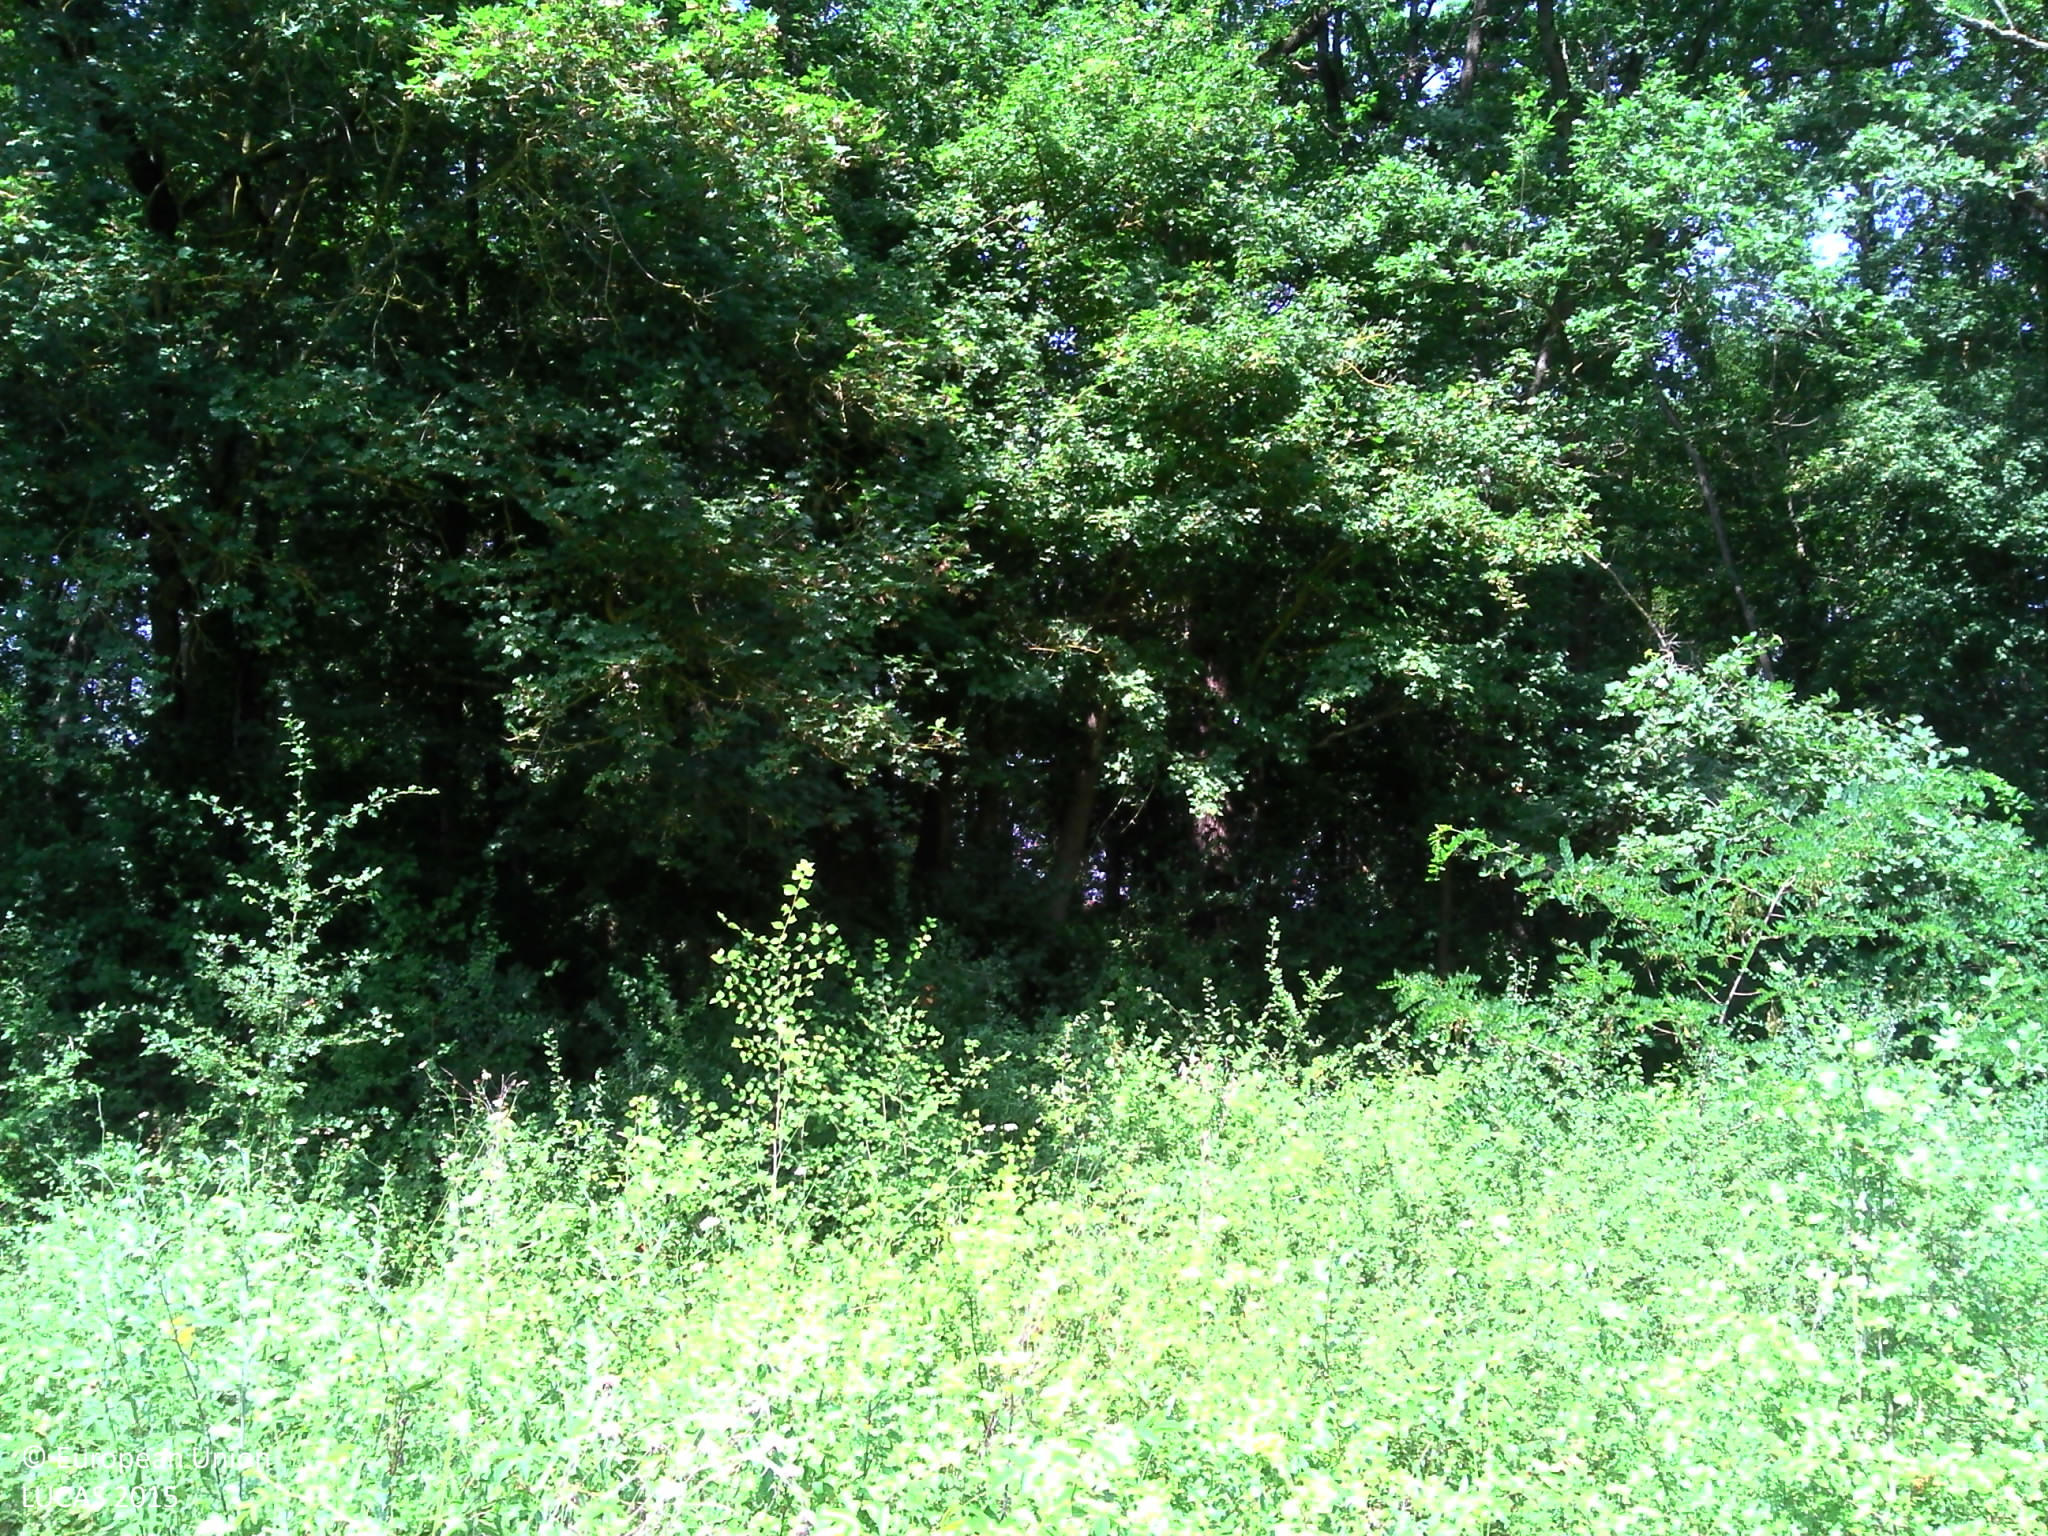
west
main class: Grassland
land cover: Spontaneously vegetated surfaces
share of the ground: > 75 %
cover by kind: herbaceous plants 100 %
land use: Semi-natural and natural areas not in use
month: July
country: FR
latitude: 43.1953
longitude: 1.4030
